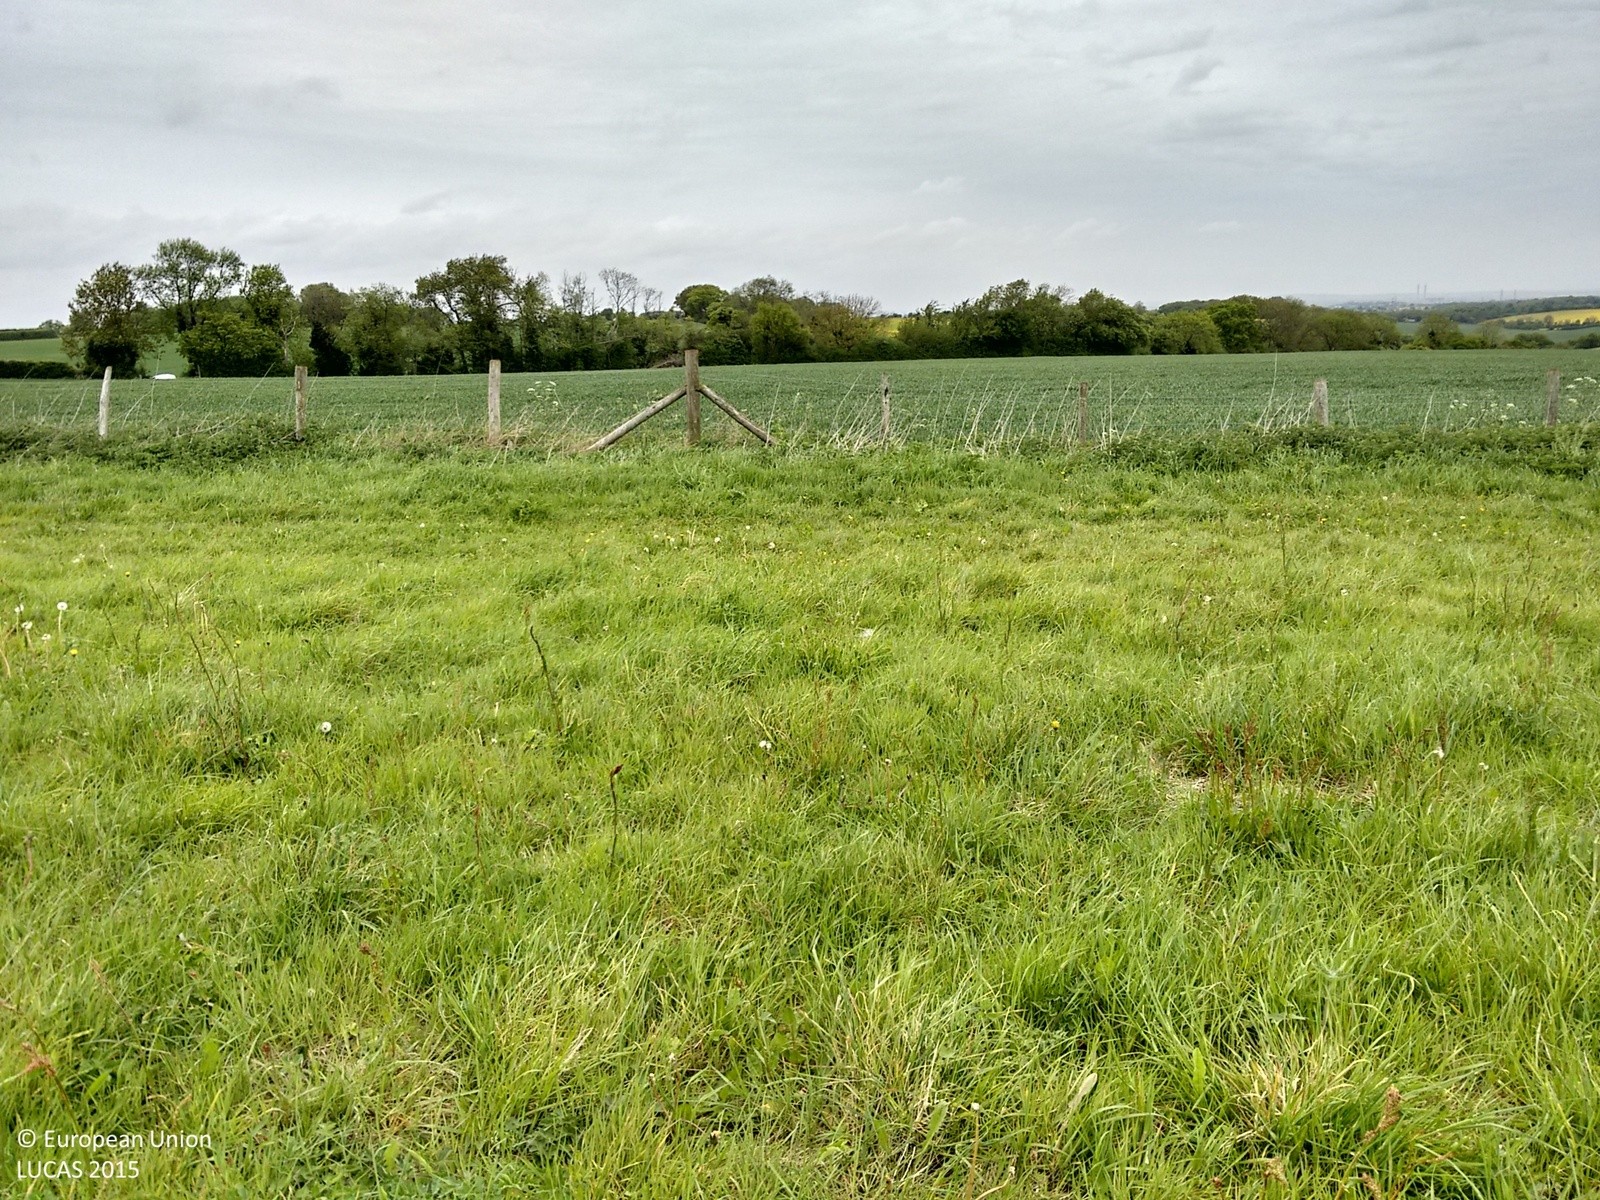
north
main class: Grassland
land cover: Grassland without tree/shrub cover
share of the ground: > 75 %
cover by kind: herbaceous plants 100 %
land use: Agriculture (excluding fallow land and kitchen gardens)
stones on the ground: < 10 %
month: May
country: GB
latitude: 51.3663
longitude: 0.3327
